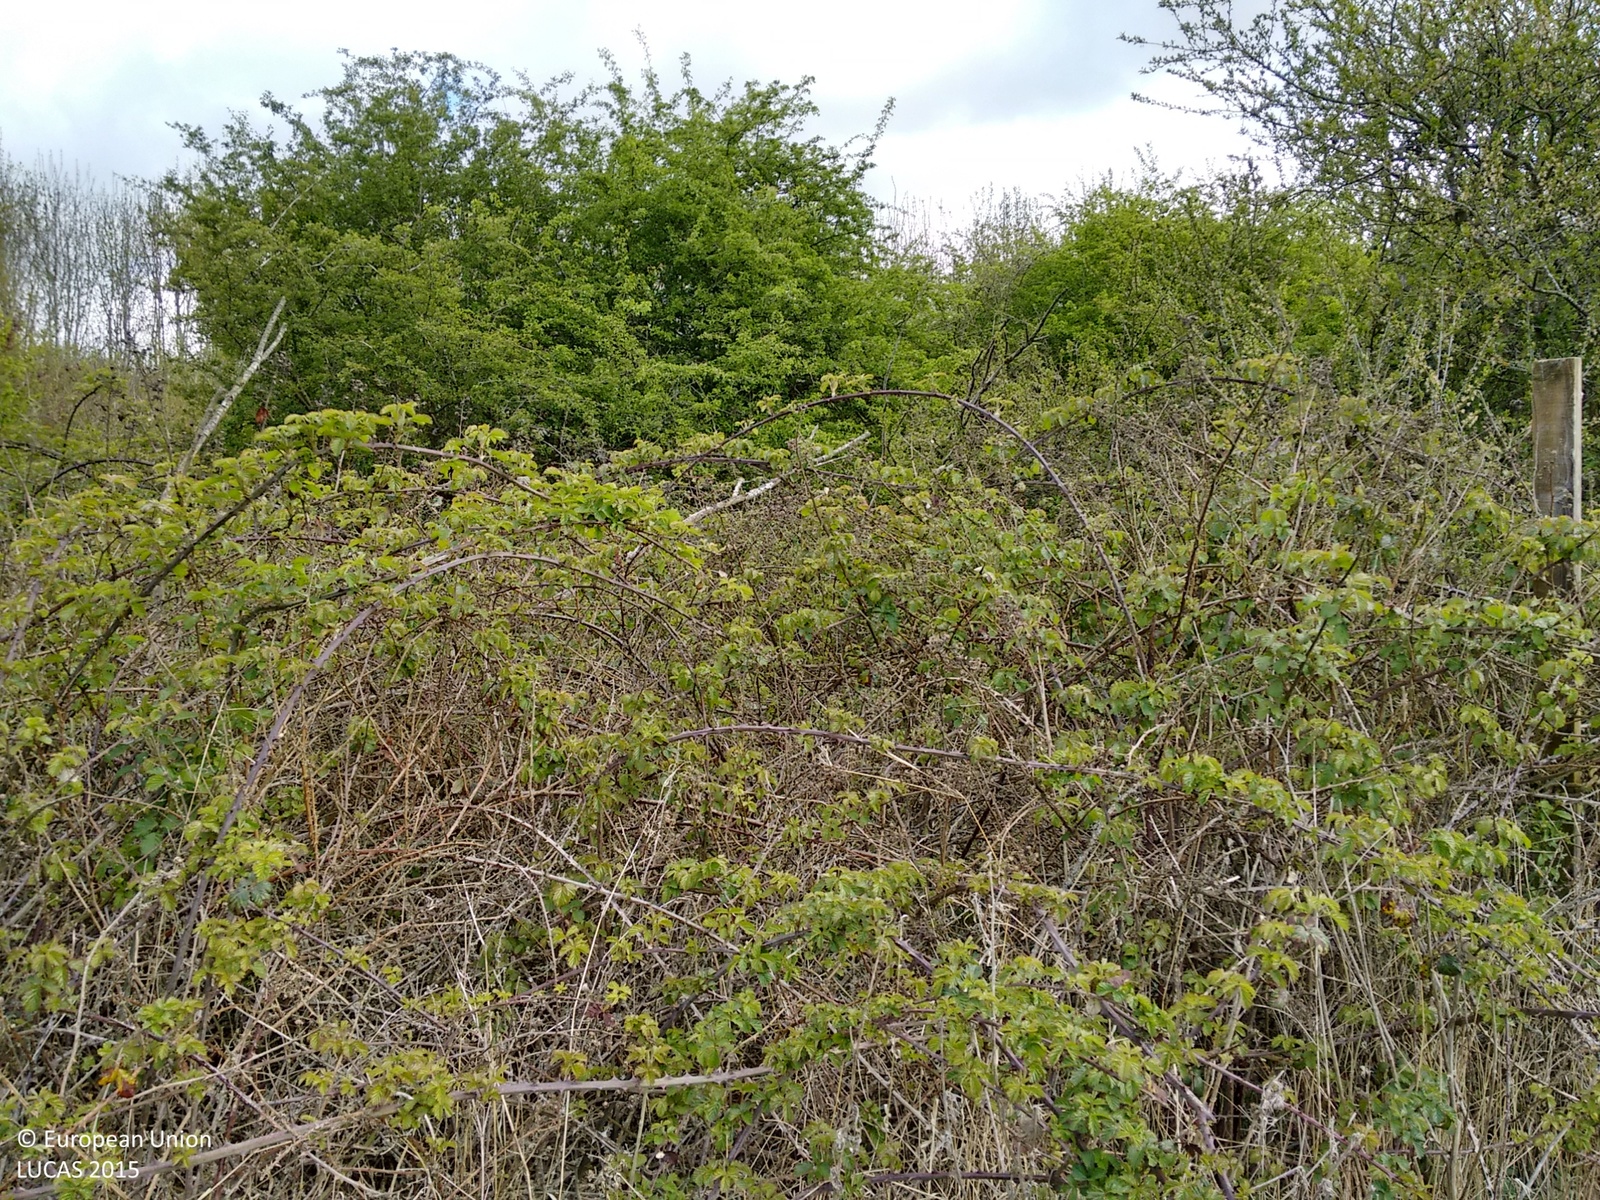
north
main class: Cropland
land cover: Nuts trees
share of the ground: > 75 %
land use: Agriculture (excluding fallow land and kitchen gardens)
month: April
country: GB
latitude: 51.8674
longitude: -0.7740
